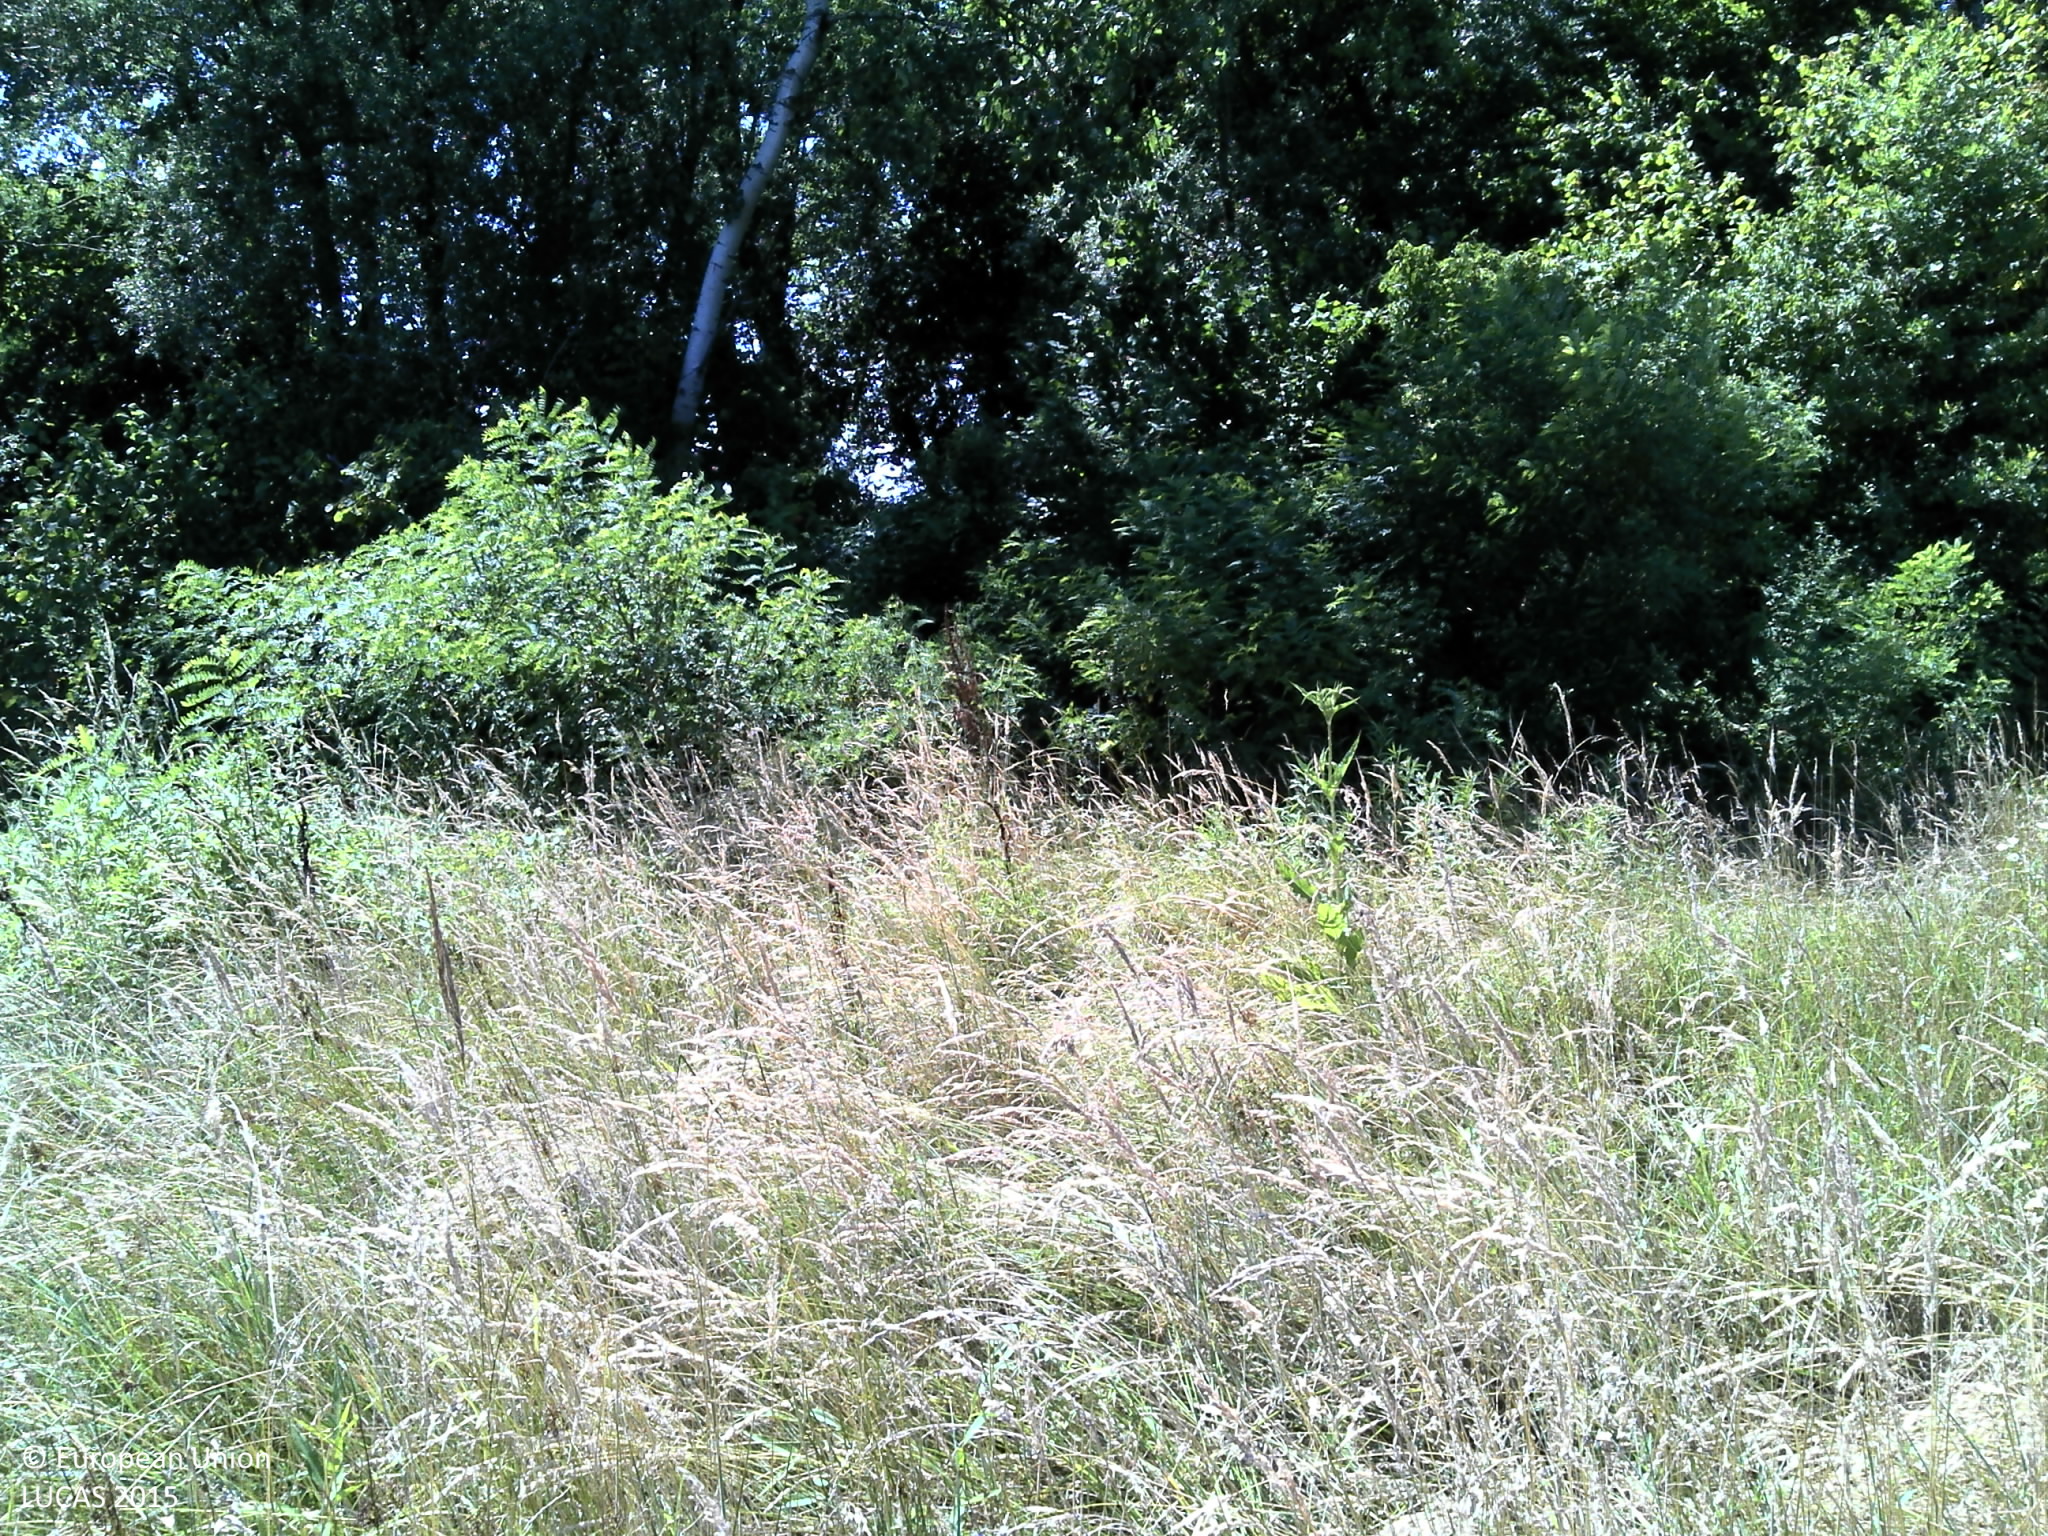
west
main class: Grassland
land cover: Grassland without tree/shrub cover
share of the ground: > 75 %
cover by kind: herbaceous plants 100 %
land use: Semi-natural and natural areas not in use
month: July
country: HR
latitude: 45.4273
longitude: 16.8368
